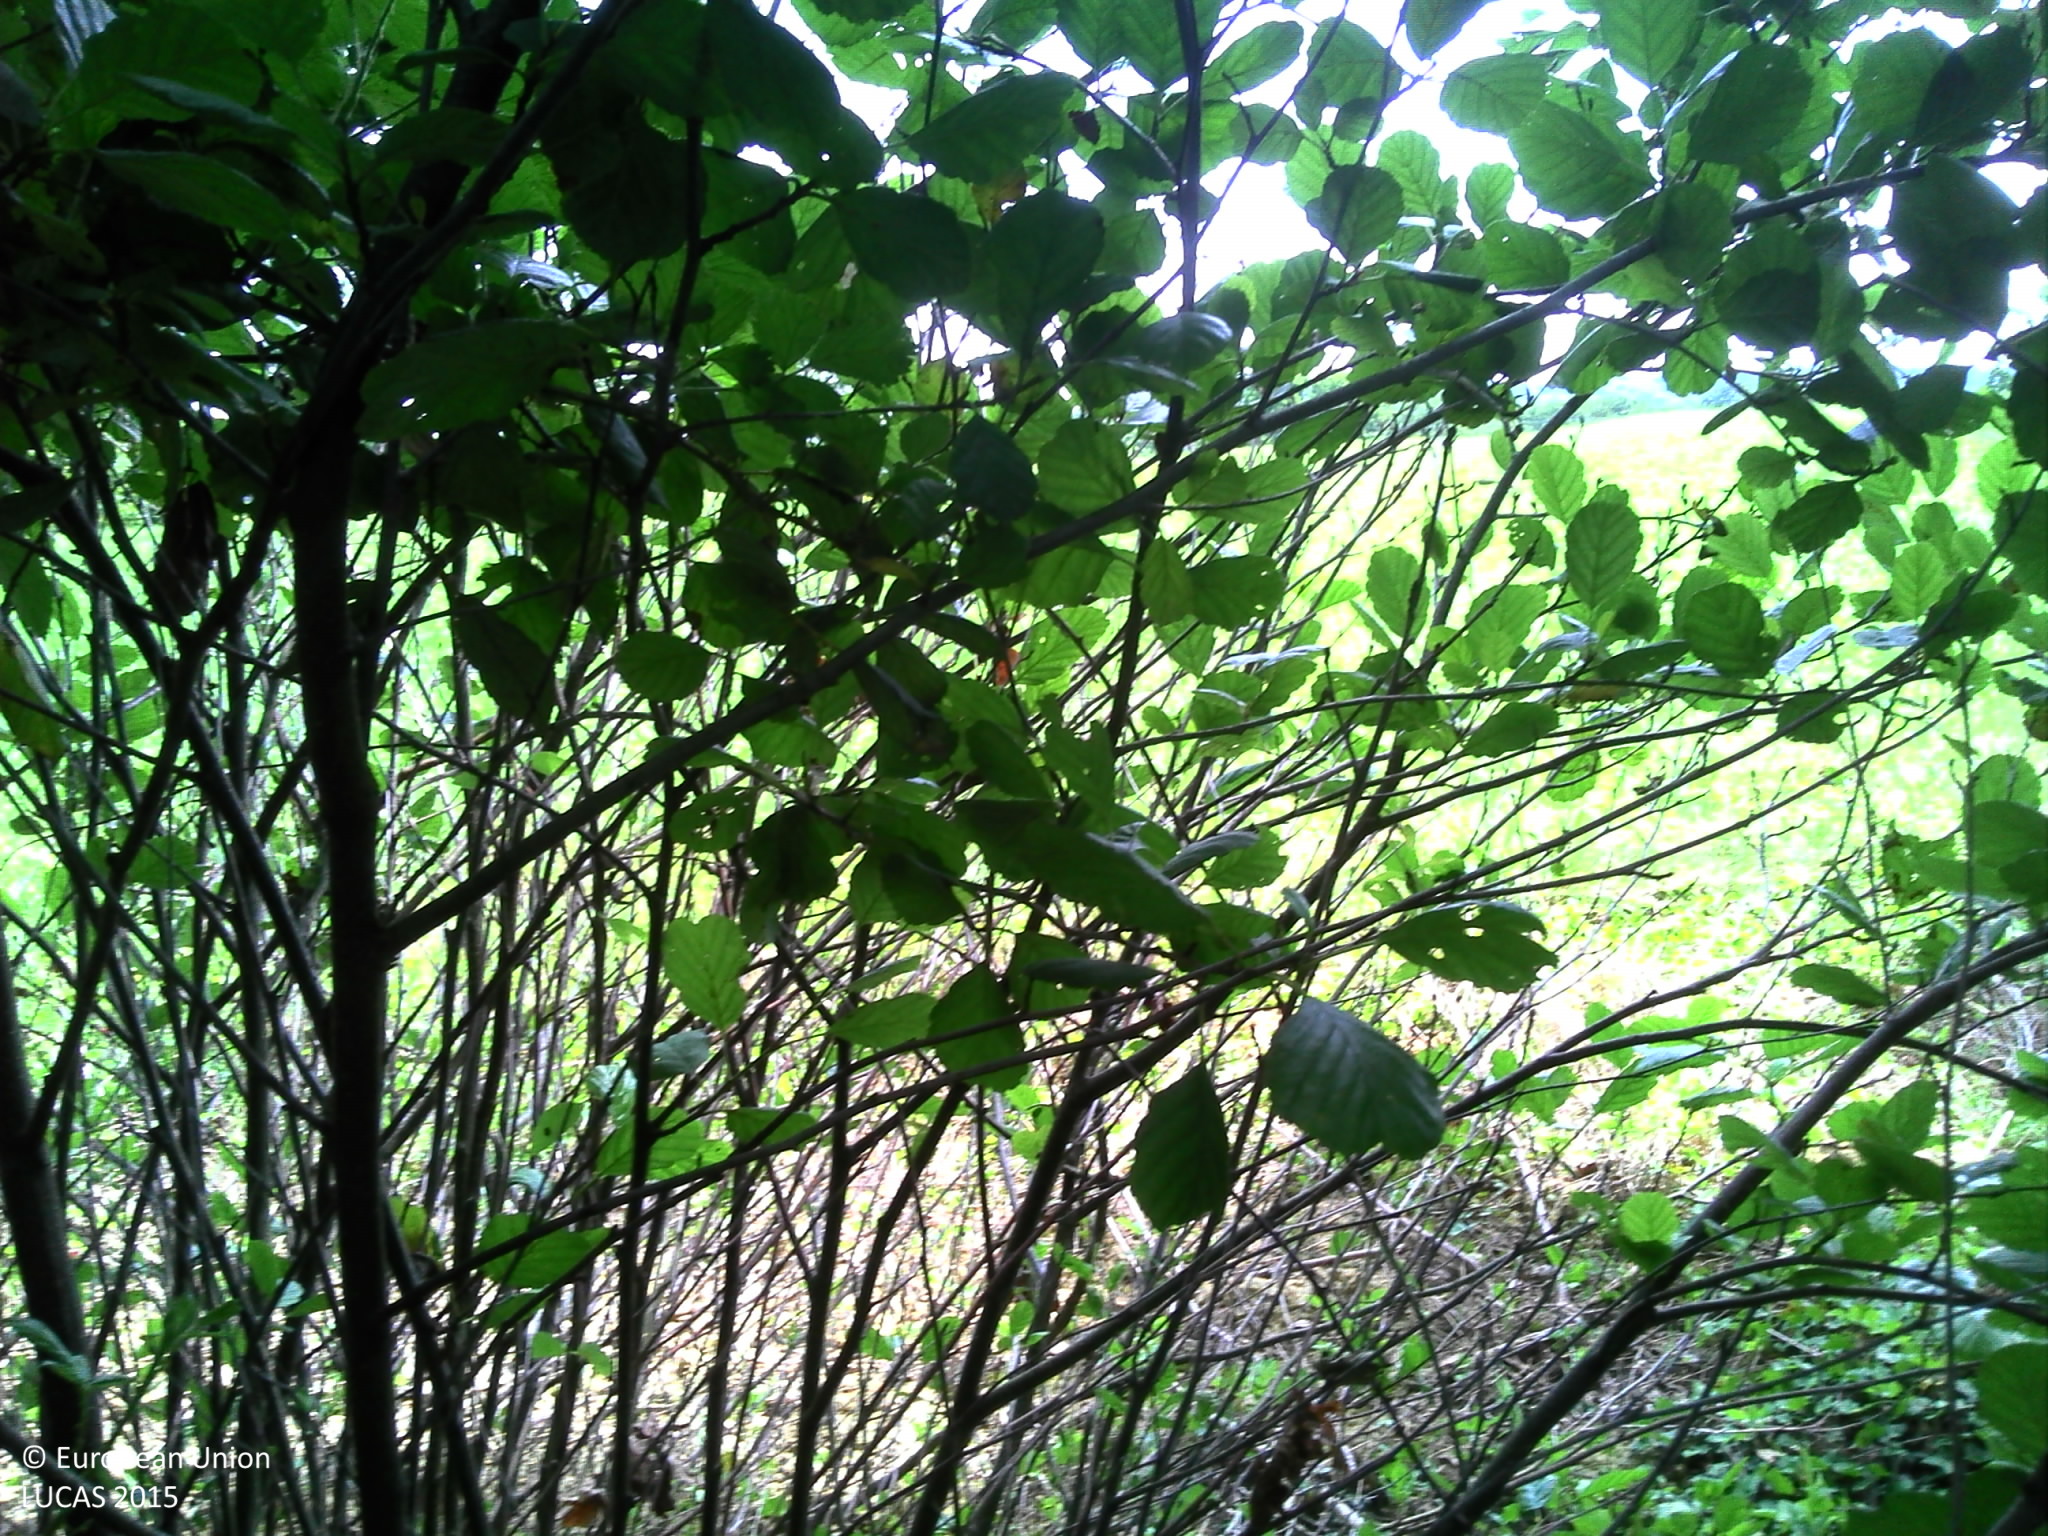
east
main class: Woodland
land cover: Broadleaved woodland
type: acidophilous oak and oak-birch forest
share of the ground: > 75 %
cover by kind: broadleaved forest trees 70 %, shrubs 20 %, herbaceous plants 10 %
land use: Forestry
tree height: > 5 m
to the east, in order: Broadleaved woodland; Grassland without tree/shrub cover; Lines of trees; Rivers and streams; Grassland without tree/shrub cover; Electric lines; Grass margins; Ditches and canals; Paved roads, cycling and walking lanes; Ditches and canals; Grass margins; Grassland without tree/shrub cover; Managed hedges; Grass margins; Railways; Managed hedges; Grassland without tree/shrub cover
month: June
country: FR
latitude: 46.4477
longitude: 5.3292
